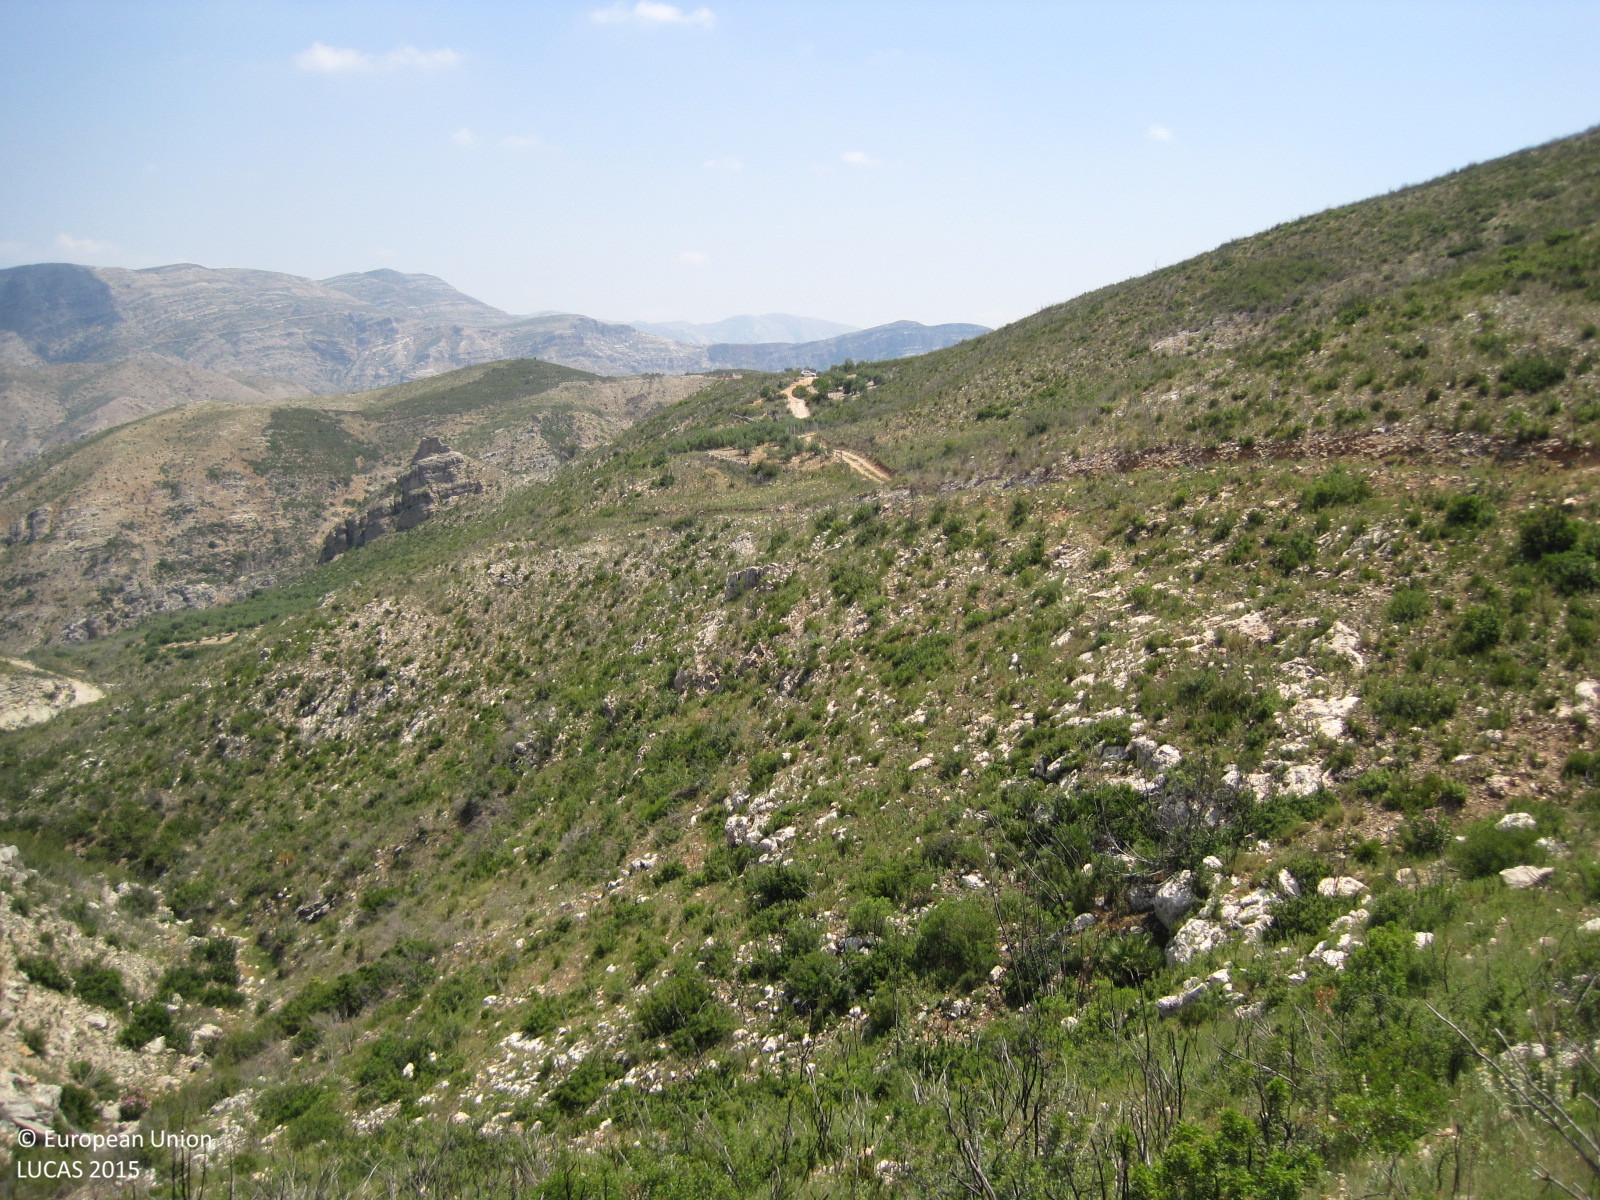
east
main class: Shrubland
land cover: Shrubland without tree cover
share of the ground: 50 - 75 %
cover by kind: shrubs 50 %, consolidated bare surface 35 %, herbaceous plants 15 %
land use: Semi-natural and natural areas not in use
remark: Burnt area
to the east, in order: Shrubland without tree cover; Fences; Olive groves
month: June
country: ES
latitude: 39.2642
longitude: -0.8338
